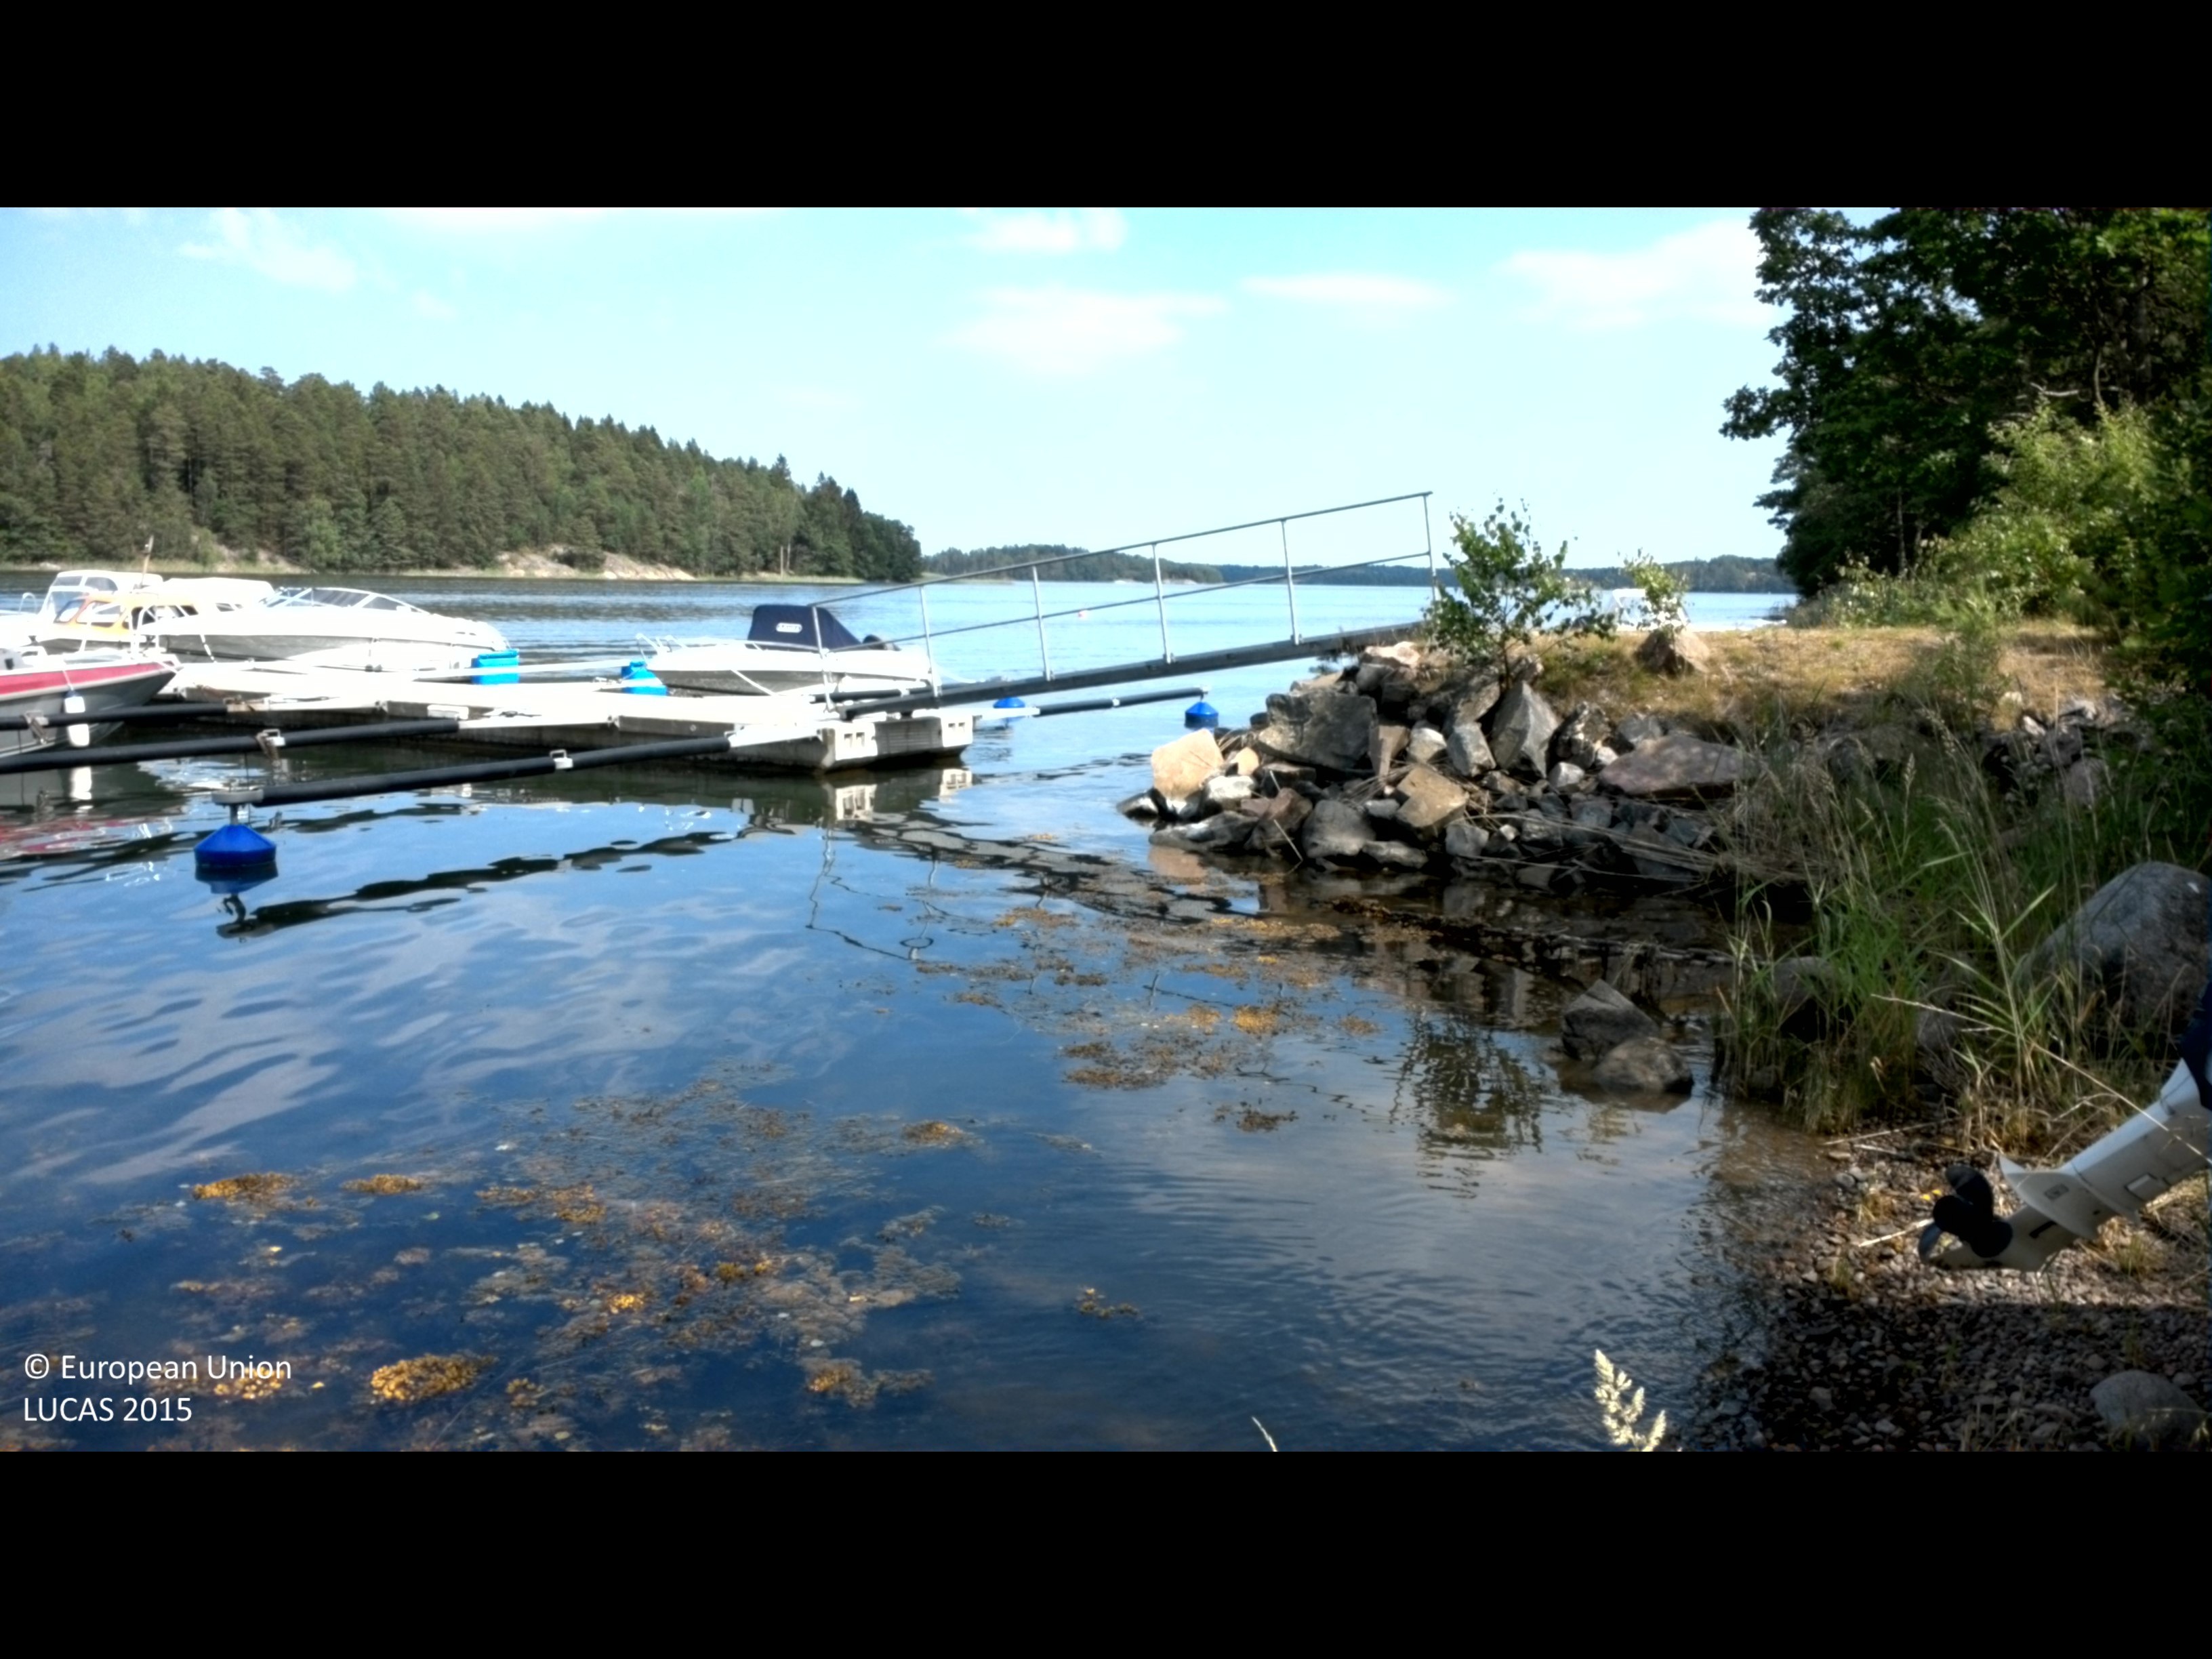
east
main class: Woodland
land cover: Broadleaved woodland
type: boreal forest
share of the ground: 50 - 75 %
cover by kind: broadleaved forest trees 65 %, shrubs 25 %, coniferous forest trees 5 %
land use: Amenities, museums, leisure
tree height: > 5 m
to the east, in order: Broadleaved woodland
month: July
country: SE
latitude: 58.3229
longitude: 16.7071
